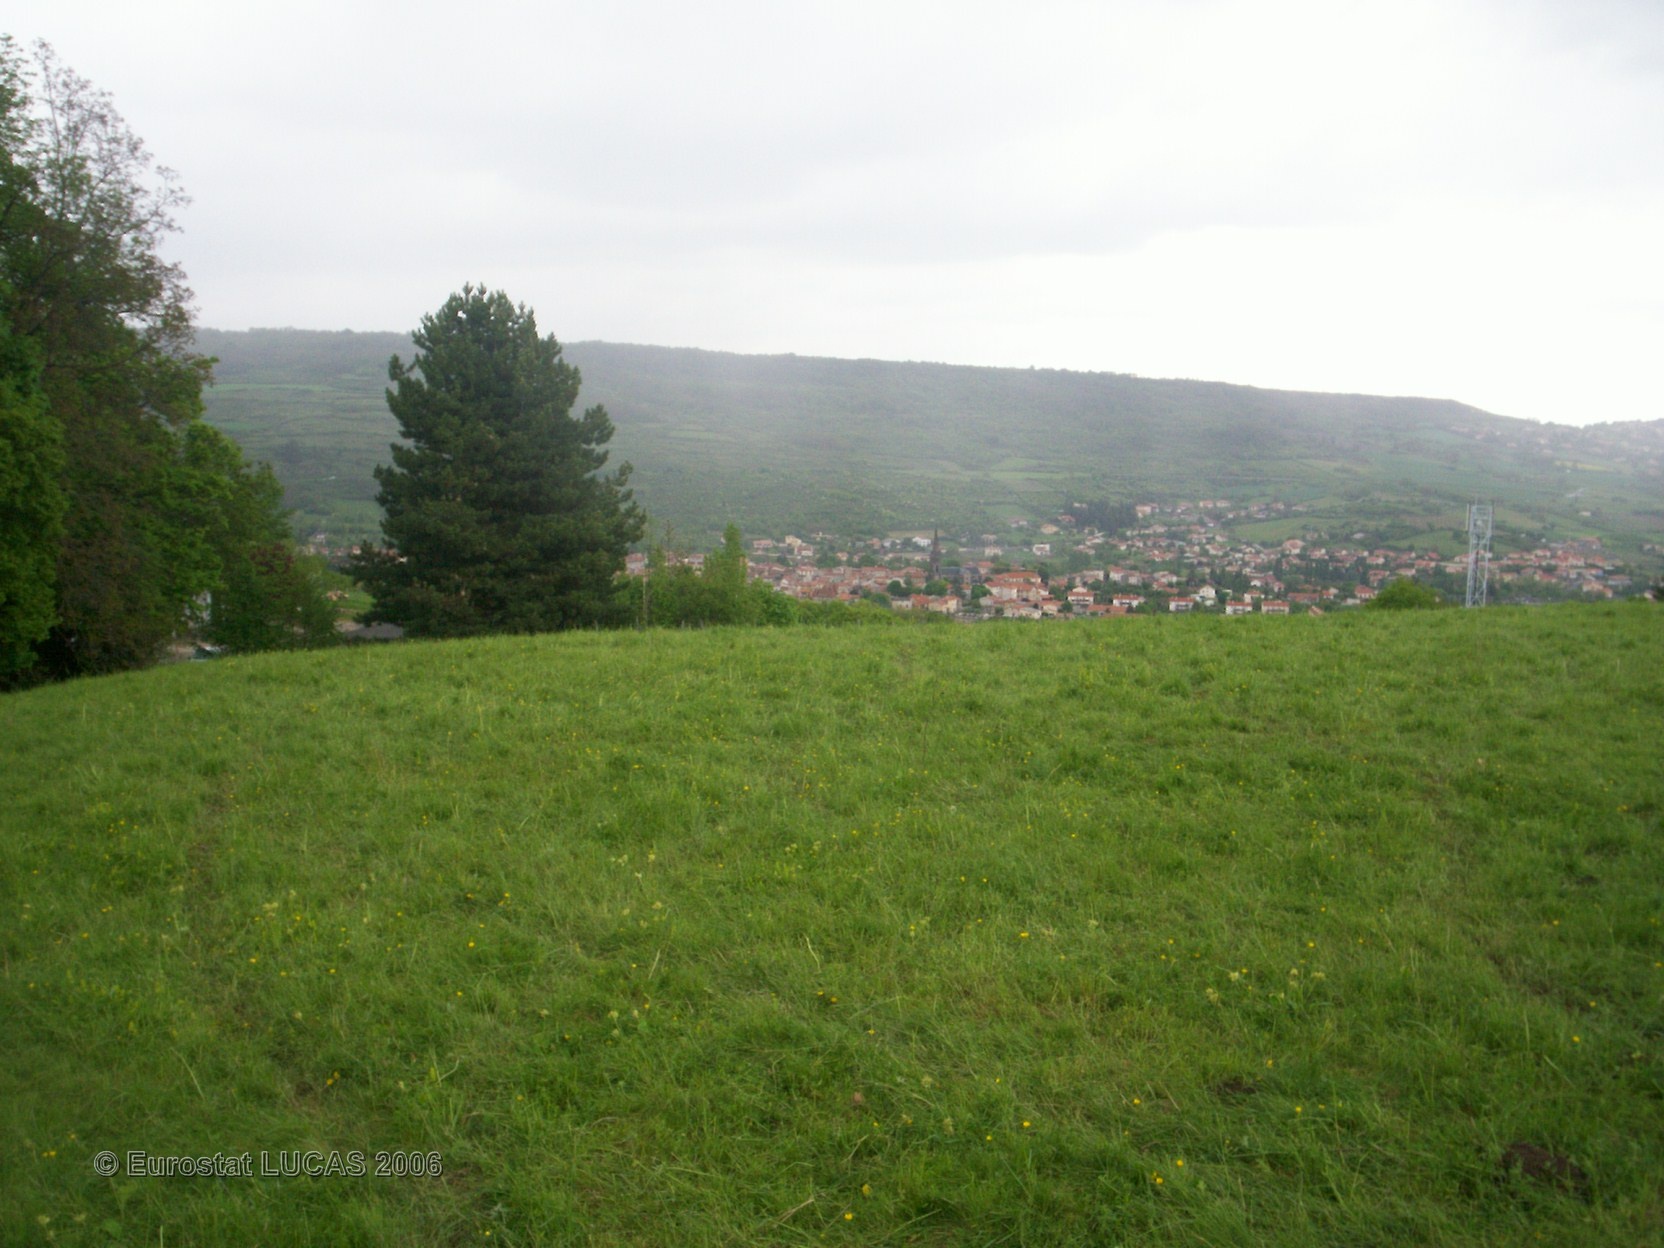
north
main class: Grassland
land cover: Grassland without tree/shrub cover
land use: Agriculture (excluding fallow land and kitchen gardens)
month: May
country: FR
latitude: 45.6588
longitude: 3.1084
